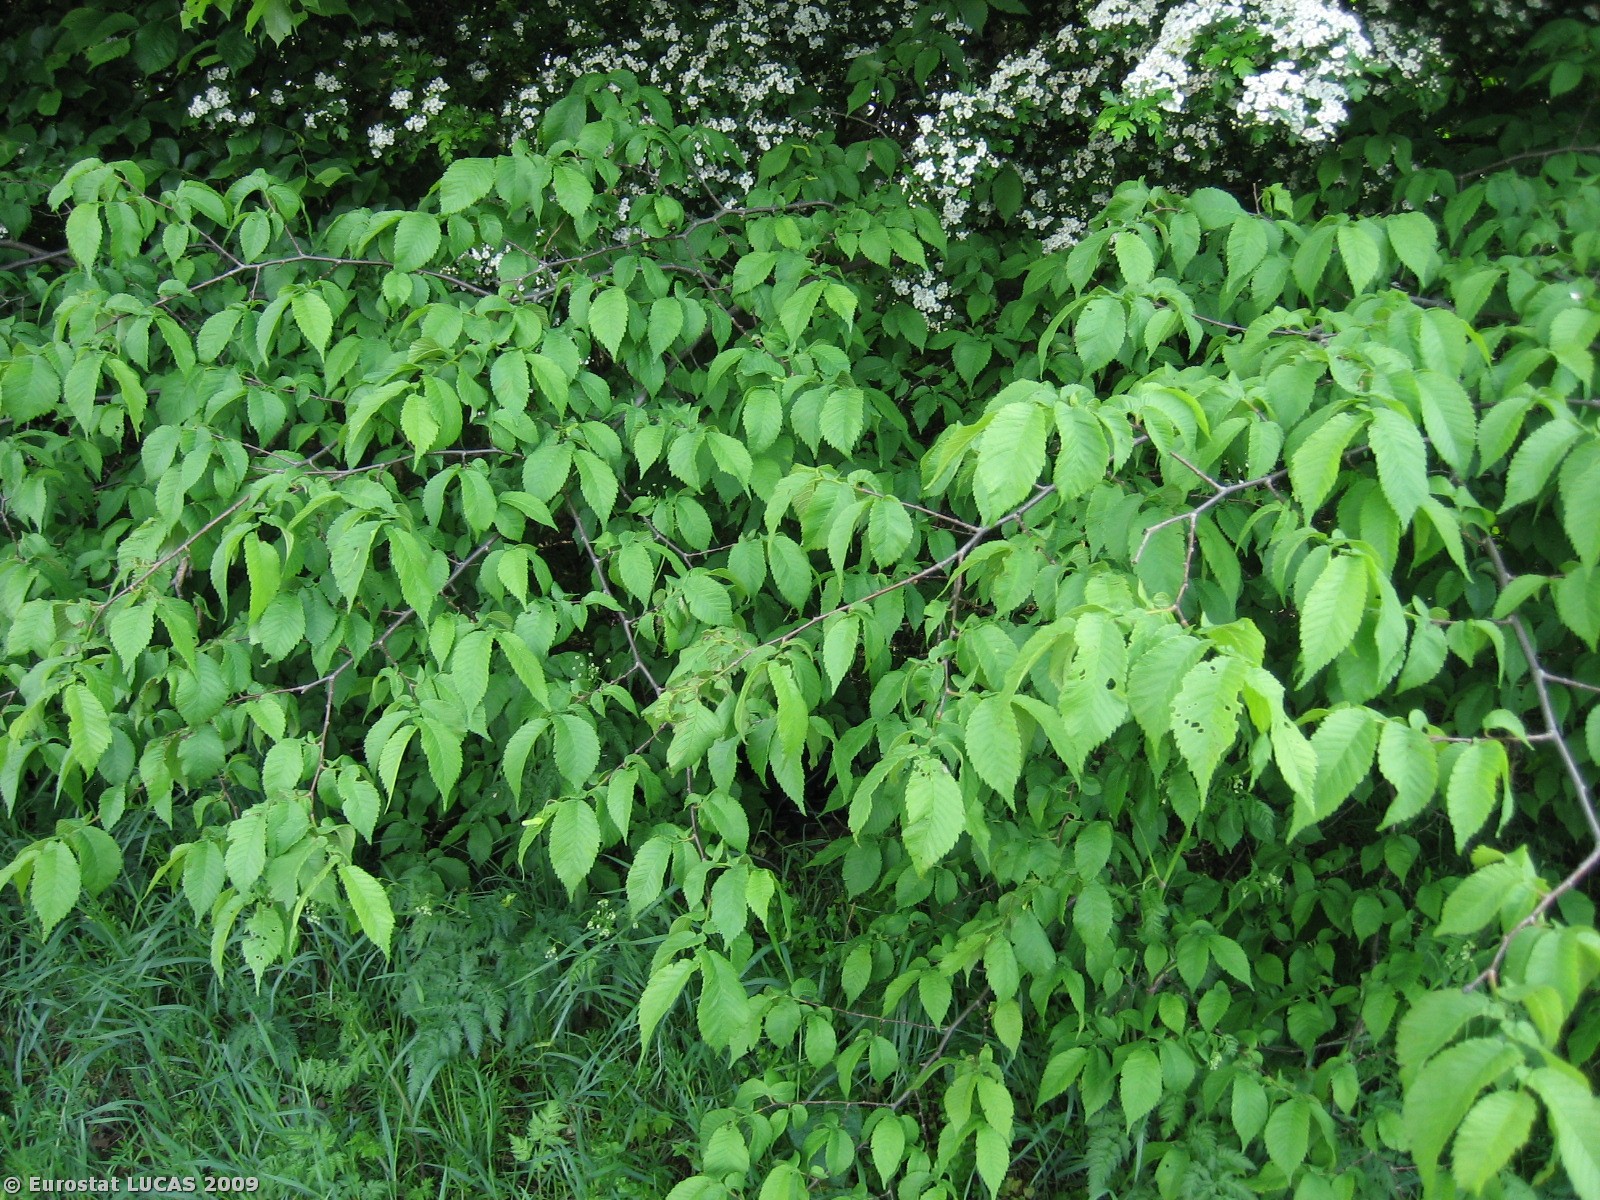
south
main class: Cropland
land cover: Maize
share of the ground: < 10 %
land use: Agriculture (excluding fallow land and kitchen gardens)
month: May
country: DK
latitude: 56.0934
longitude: 8.9243
